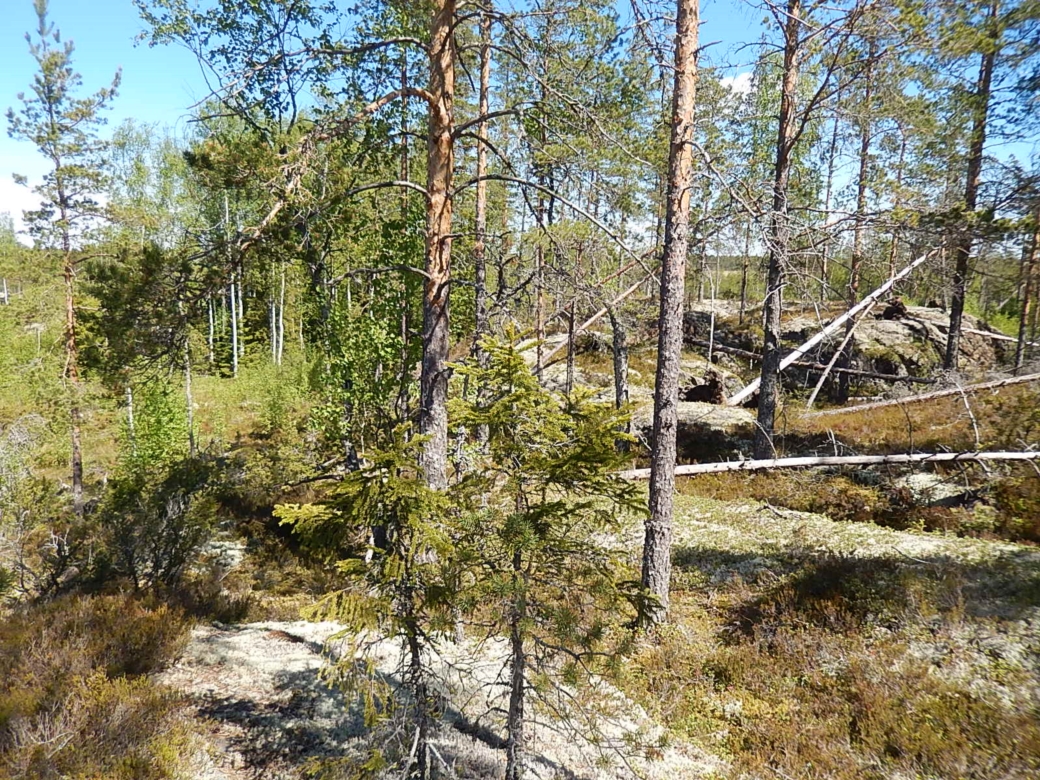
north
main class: Woodland
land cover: Pine dominated coniferous woodland
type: boreal forest
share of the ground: 50 - 75 %
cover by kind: coniferous forest trees 45 %, shrubs 25 %, lichens and mosses 25 %, broadleaved forest trees 5 %
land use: Forestry
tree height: > 5 m
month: June
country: FI
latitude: 62.0544
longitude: 21.5816
